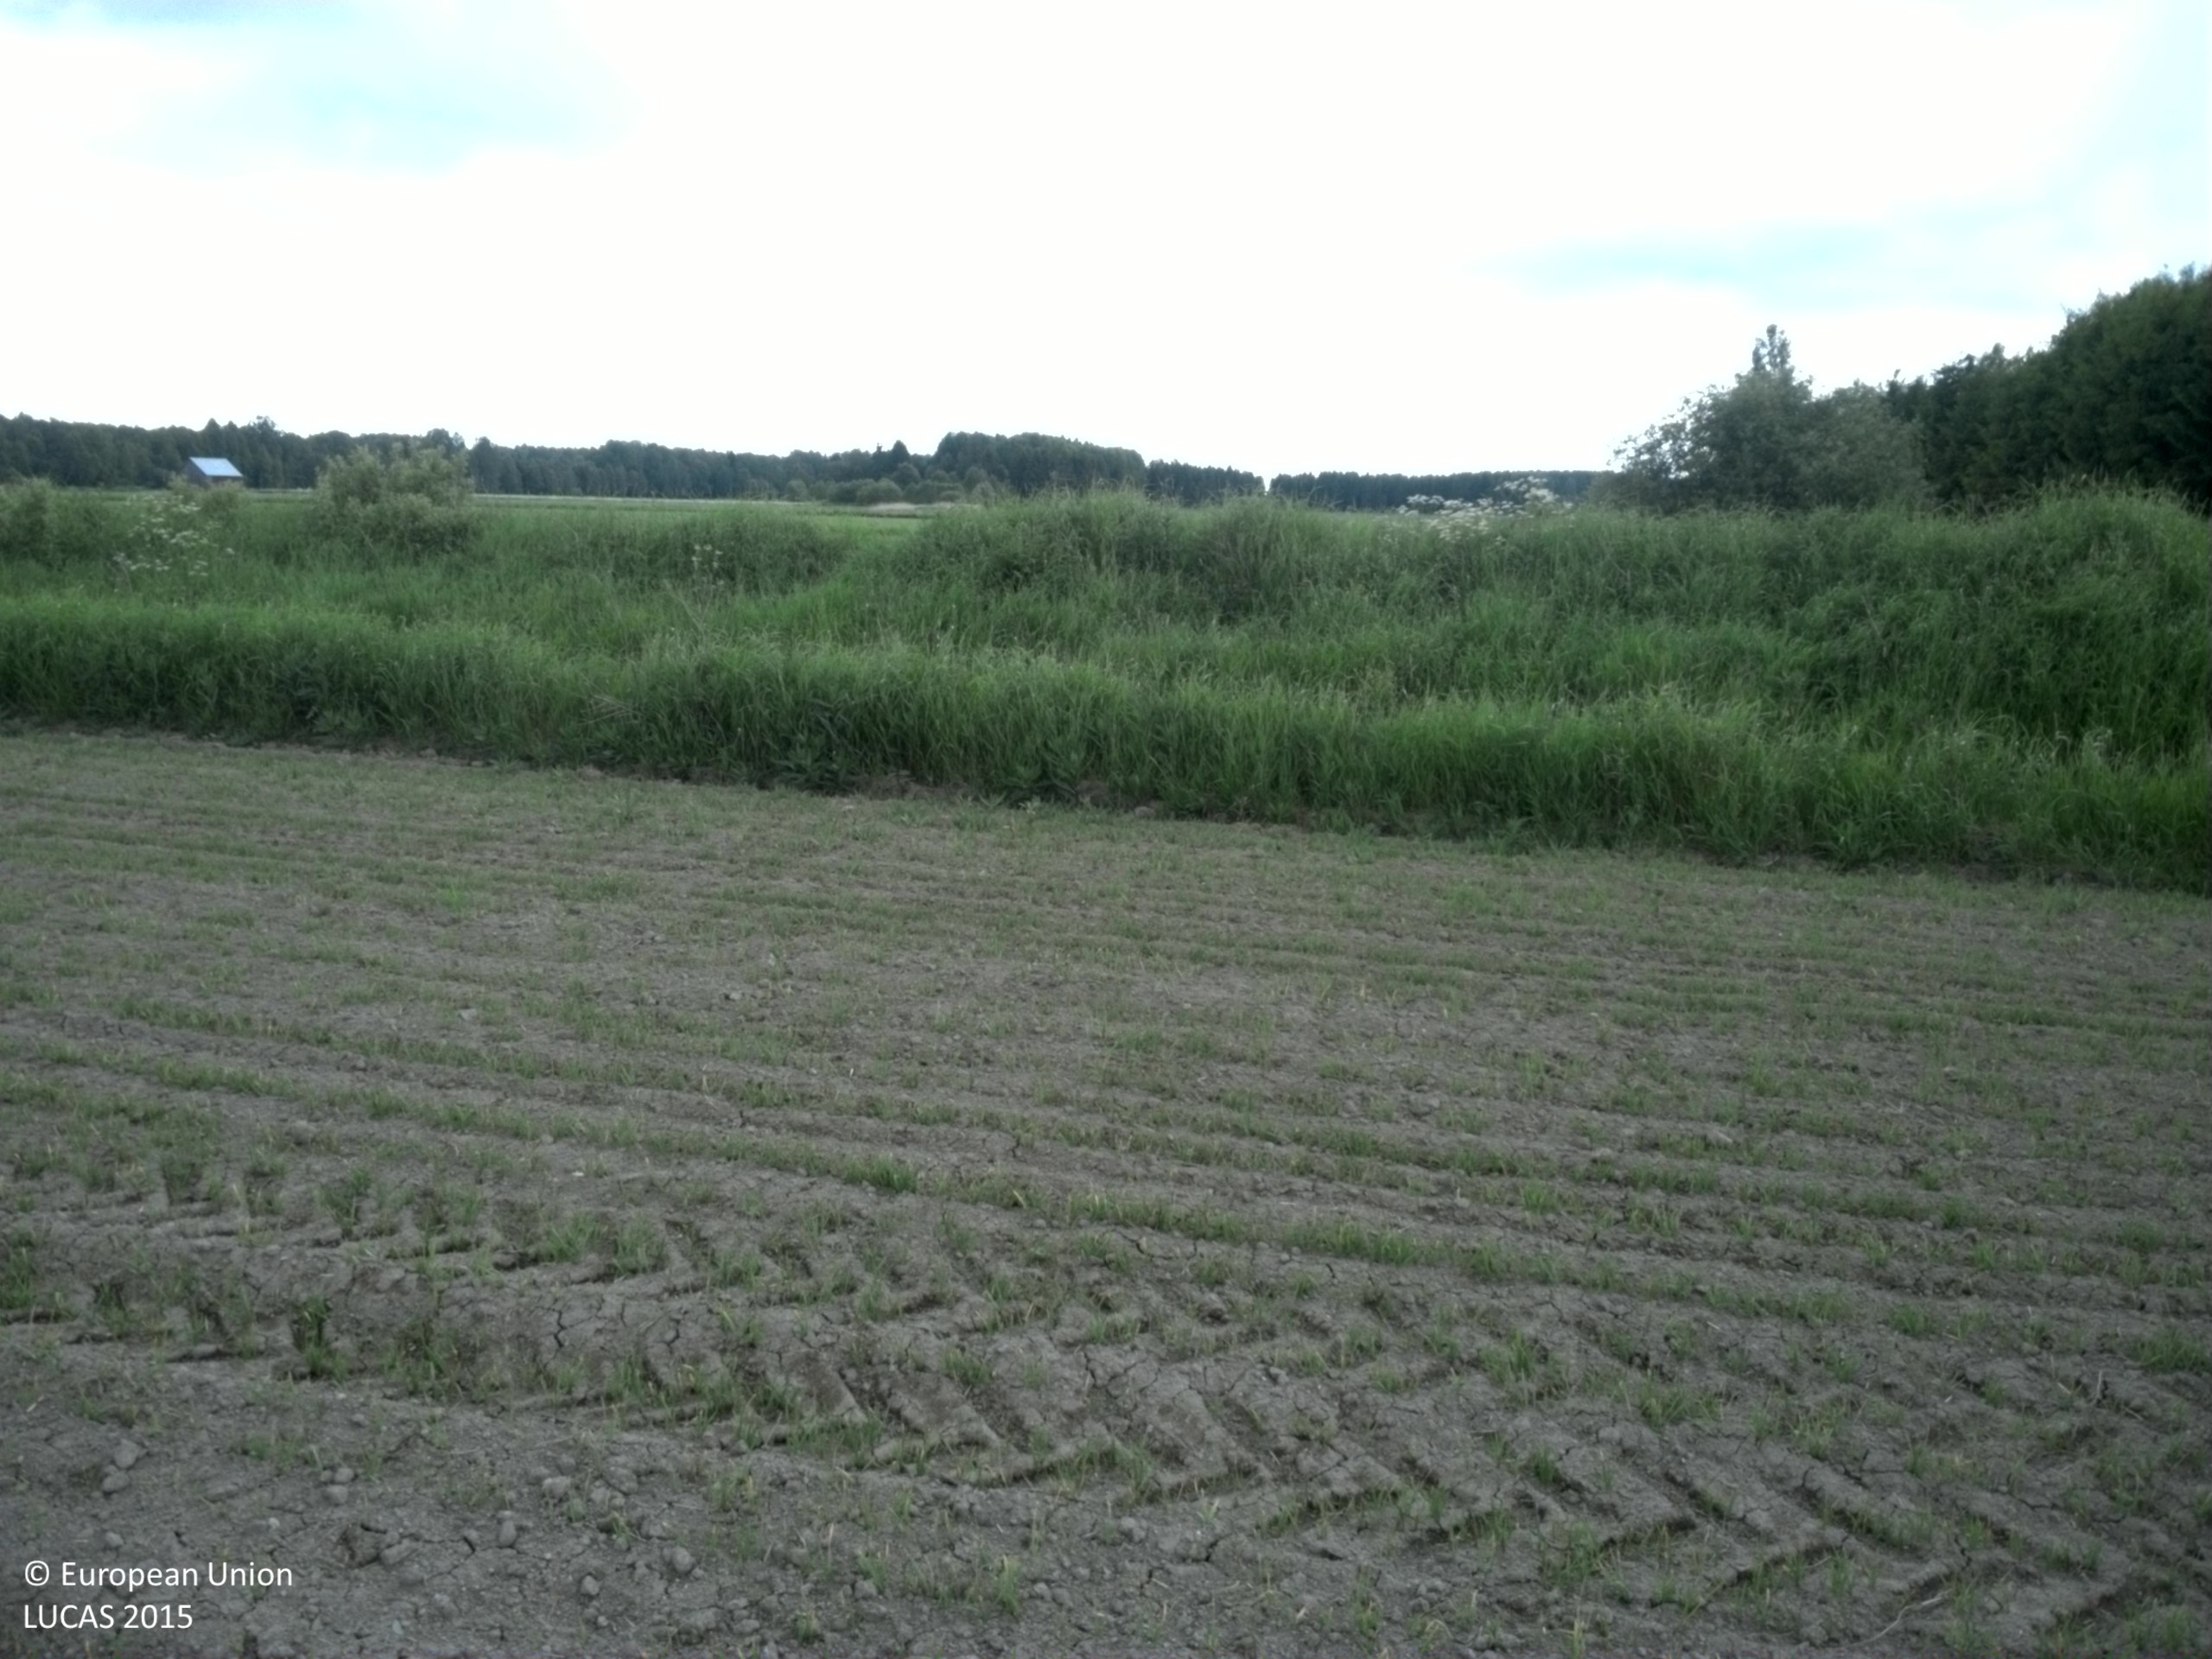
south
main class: Cropland
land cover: Barley
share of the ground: 25 - 50 %
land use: Agriculture (excluding fallow land and kitchen gardens)
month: June
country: SE
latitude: 60.2950
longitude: 17.7177
